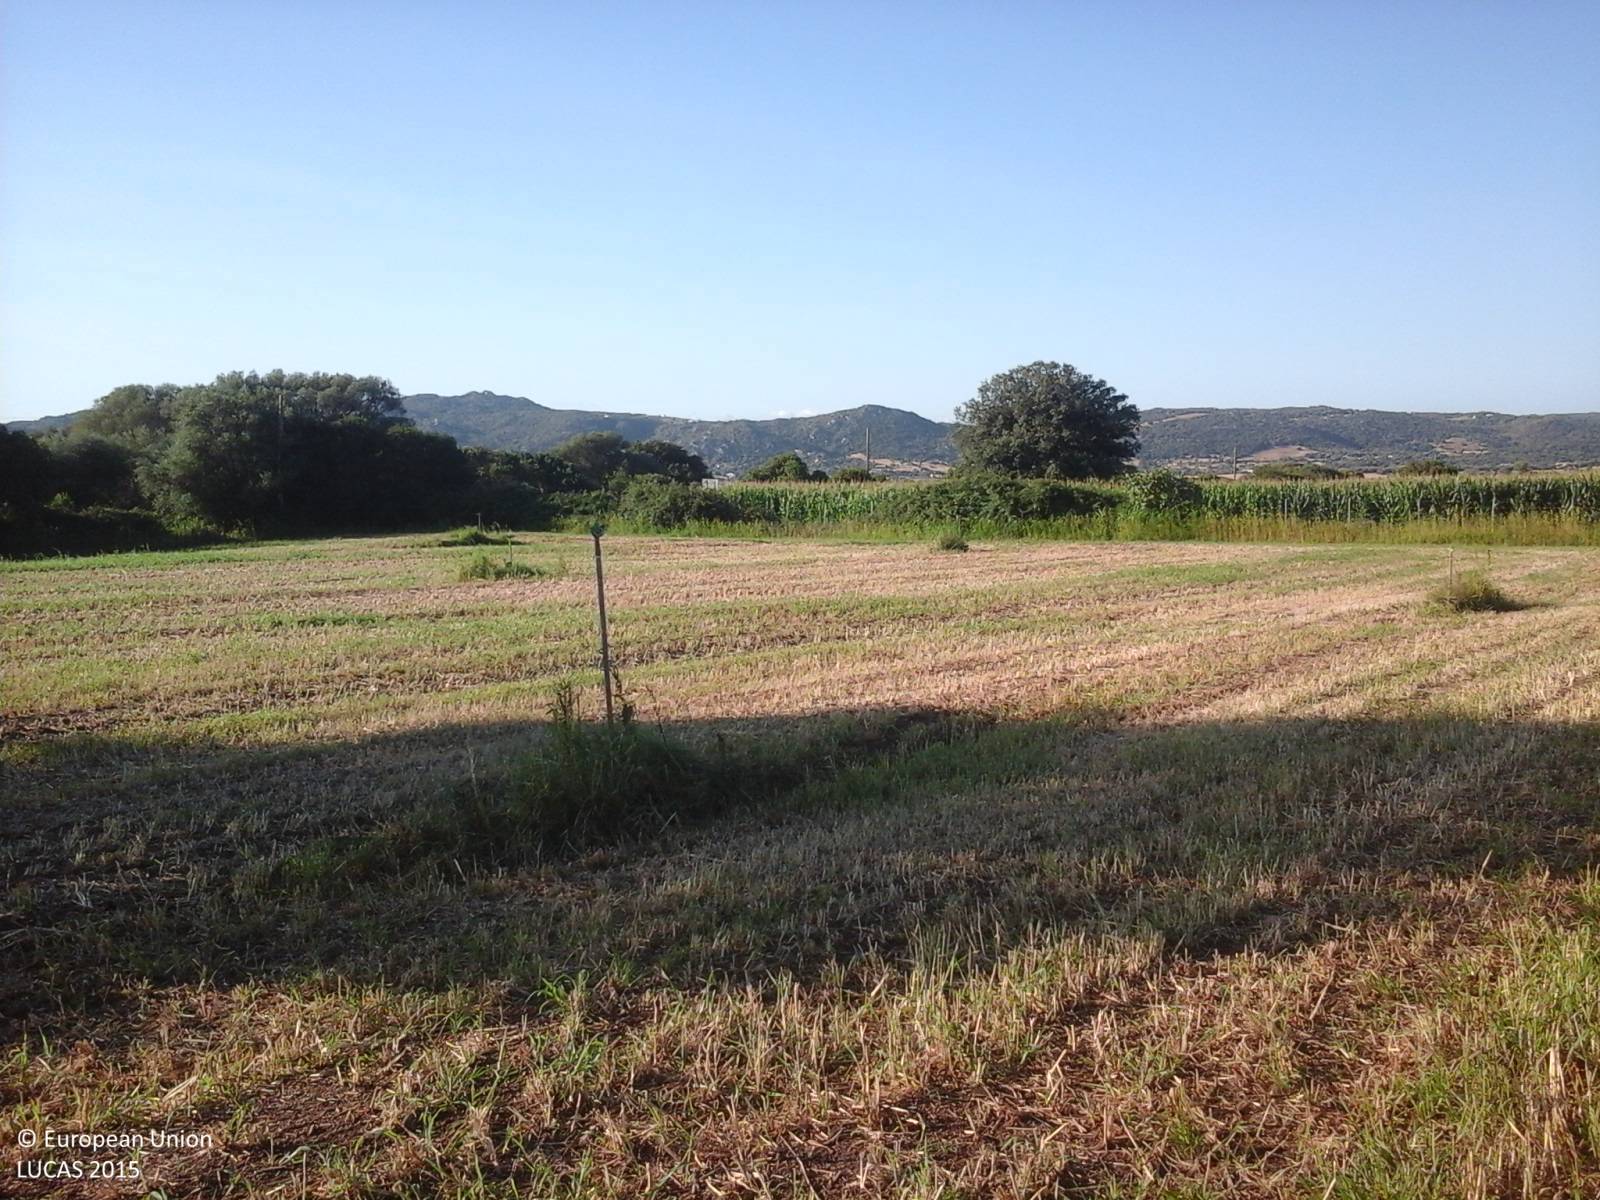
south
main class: Grassland
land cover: Grassland without tree/shrub cover
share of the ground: > 75 %
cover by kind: herbaceous plants 95 %, unconsolidated bare surface 5 %
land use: Agriculture (excluding fallow land and kitchen gardens)
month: August
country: IT
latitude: 40.9352
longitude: 9.4208
